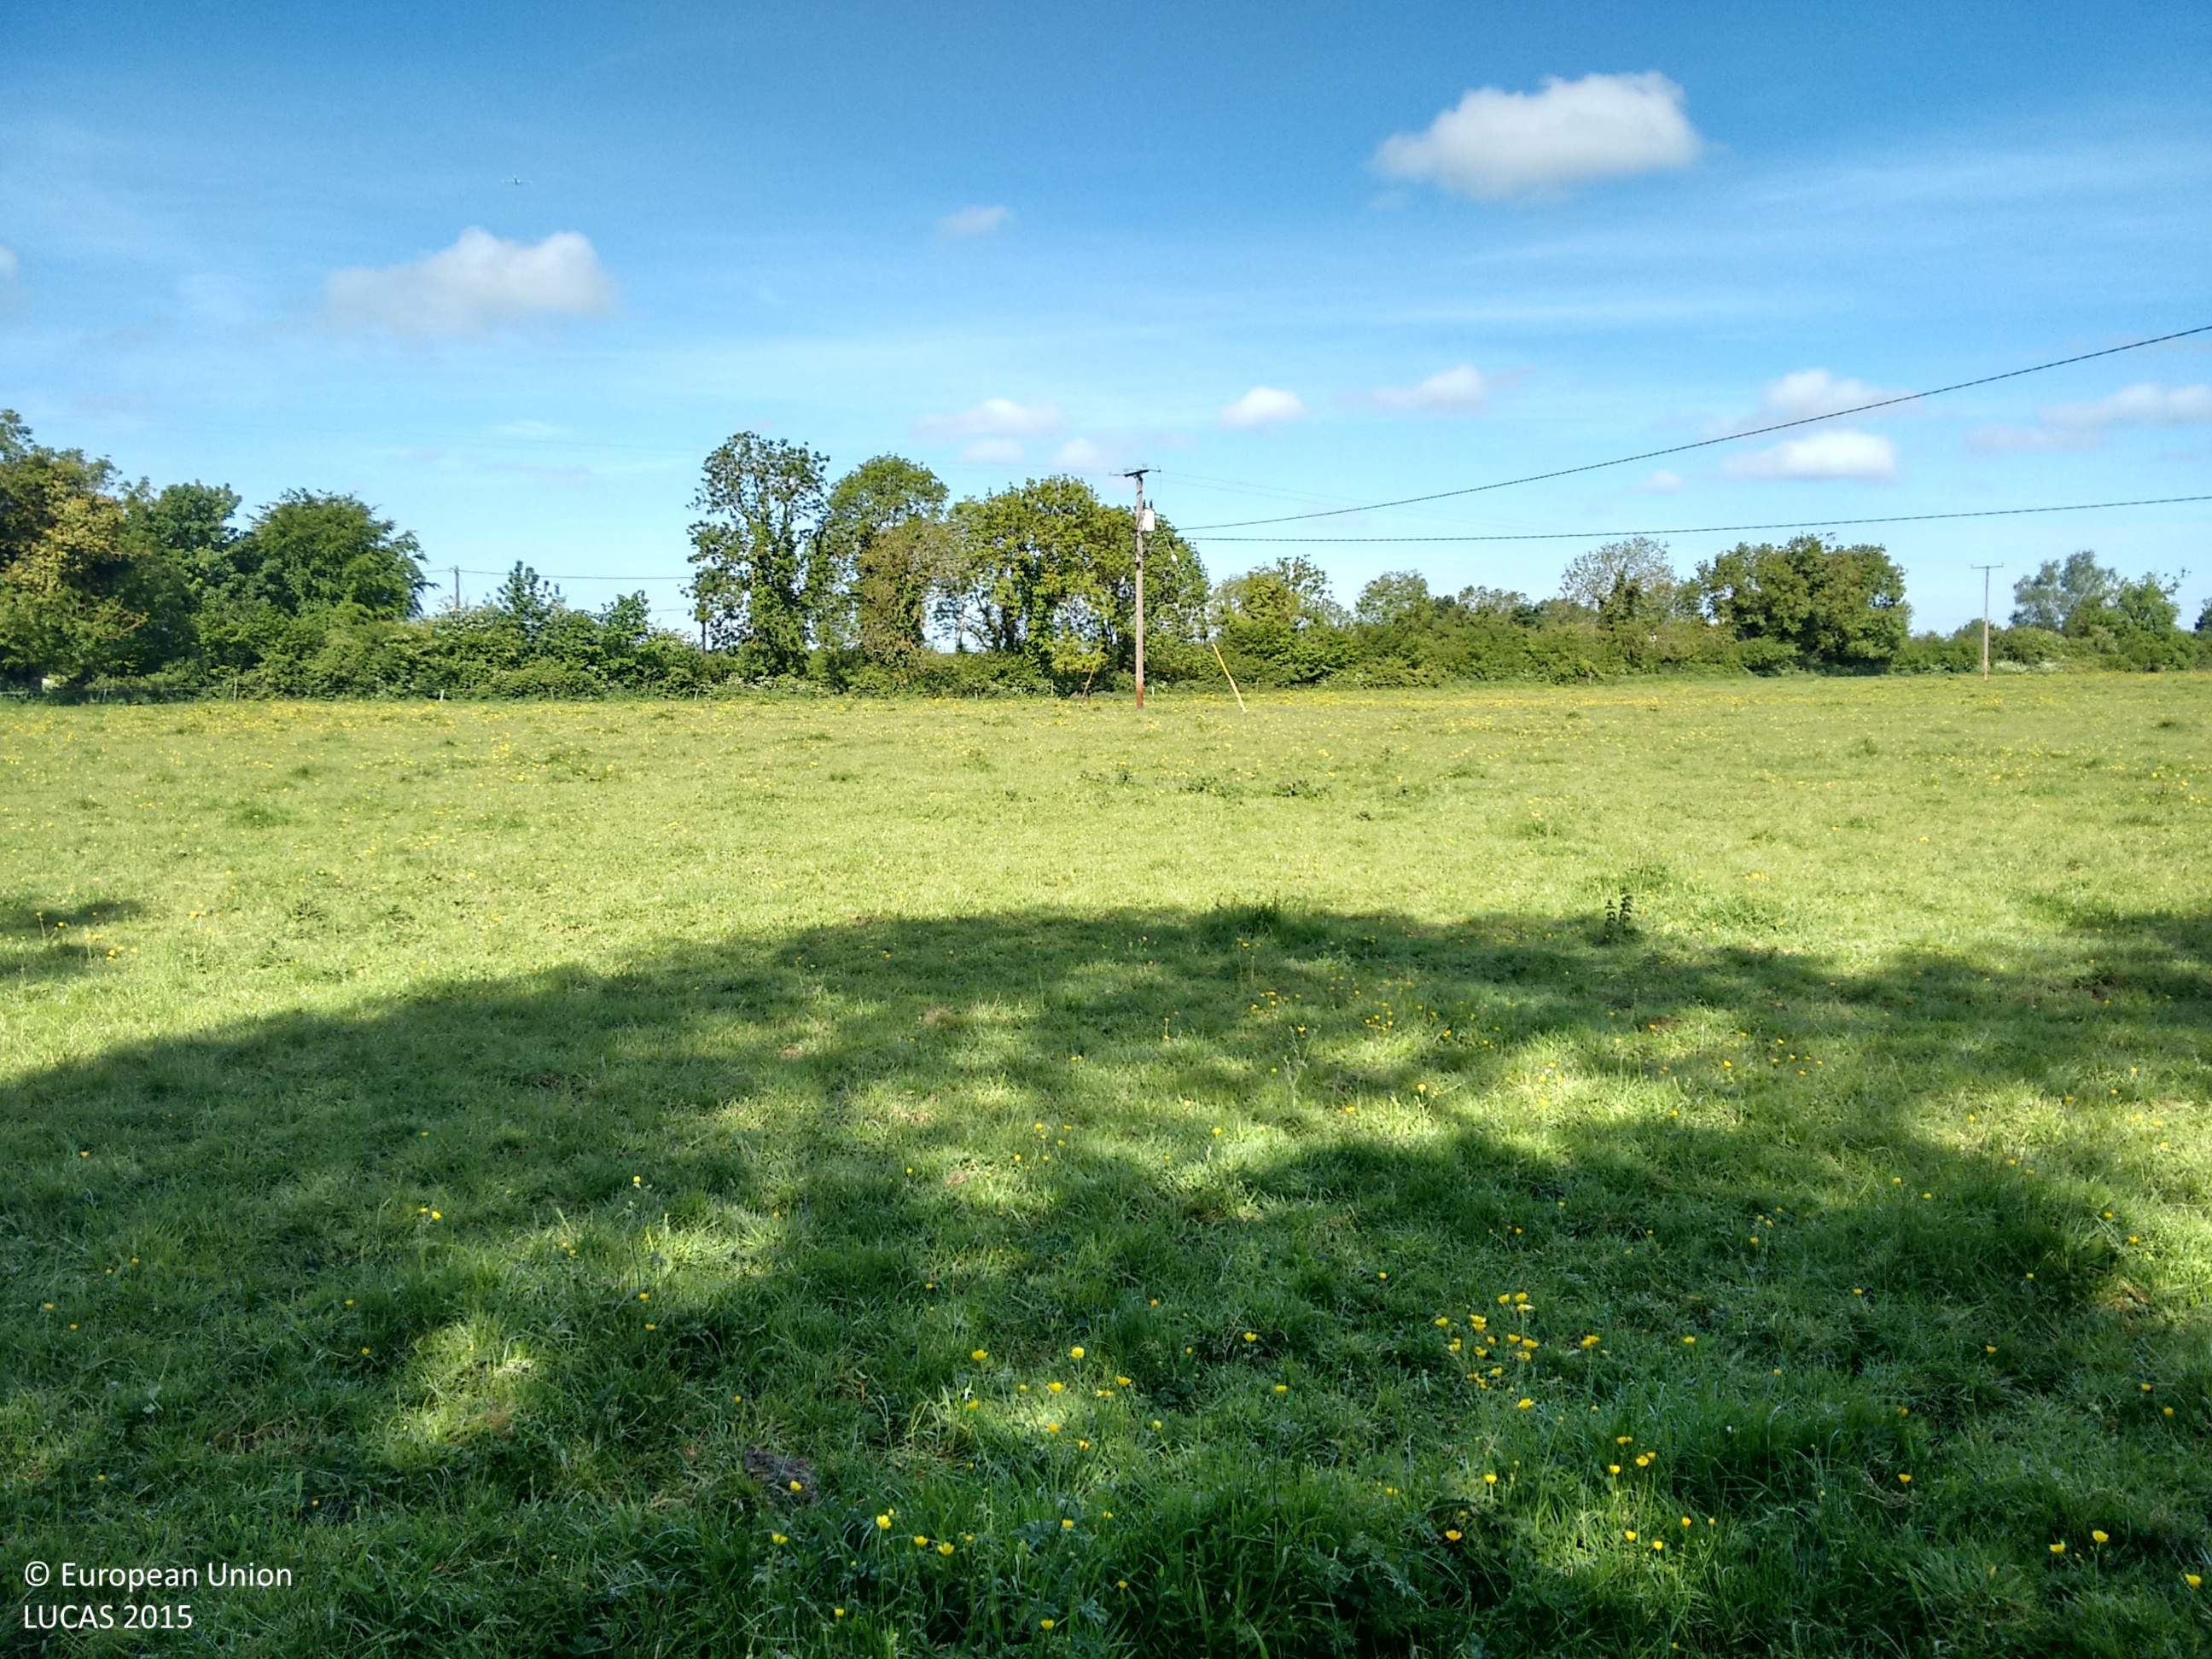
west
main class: Grassland
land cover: Grassland without tree/shrub cover
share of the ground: > 75 %
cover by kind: herbaceous plants 90 %, unconsolidated bare surface 10 %
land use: Agriculture (excluding fallow land and kitchen gardens)
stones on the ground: < 10 %
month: June
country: IE
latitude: 53.4363
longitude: -6.4889
